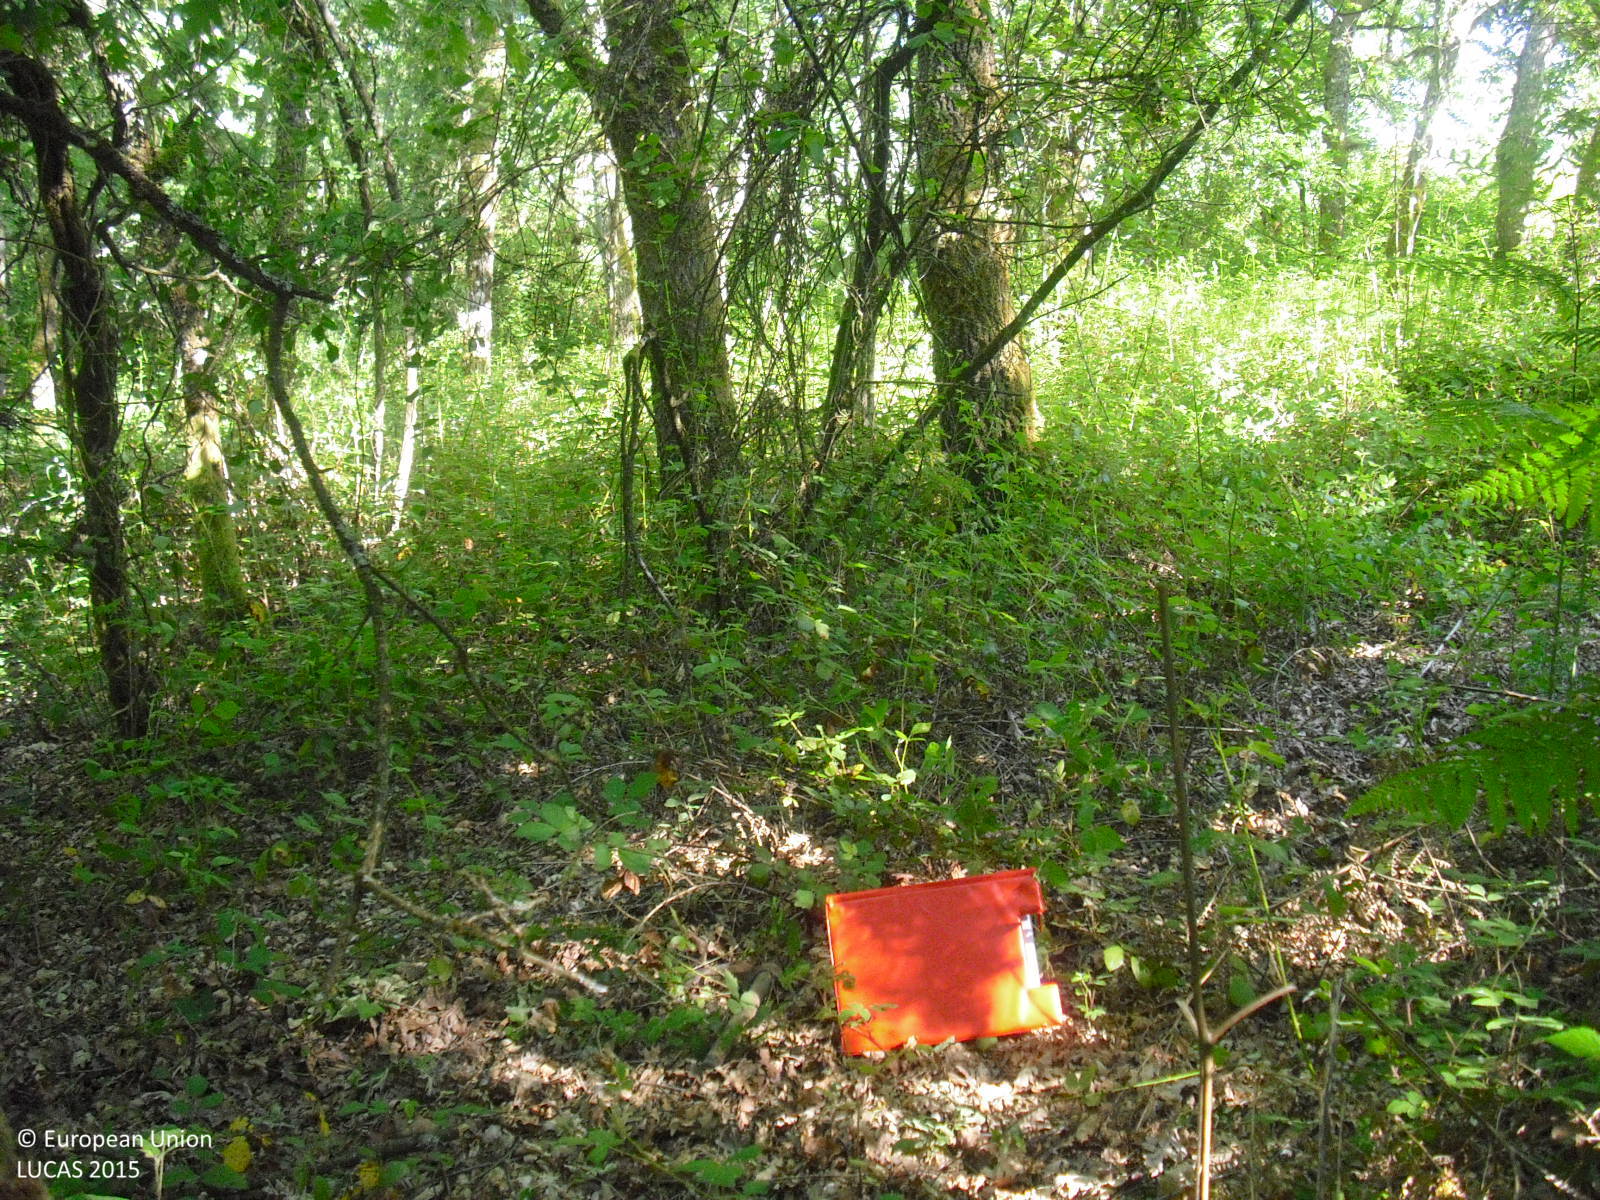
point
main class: Woodland
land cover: Broadleaved woodland
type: thermophilous deciduous forest
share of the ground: > 75 %
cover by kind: broadleaved forest trees 100 %
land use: Forestry
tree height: > 5 m
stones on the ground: < 10 %
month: May
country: ES
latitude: 42.2634
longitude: -7.6857
